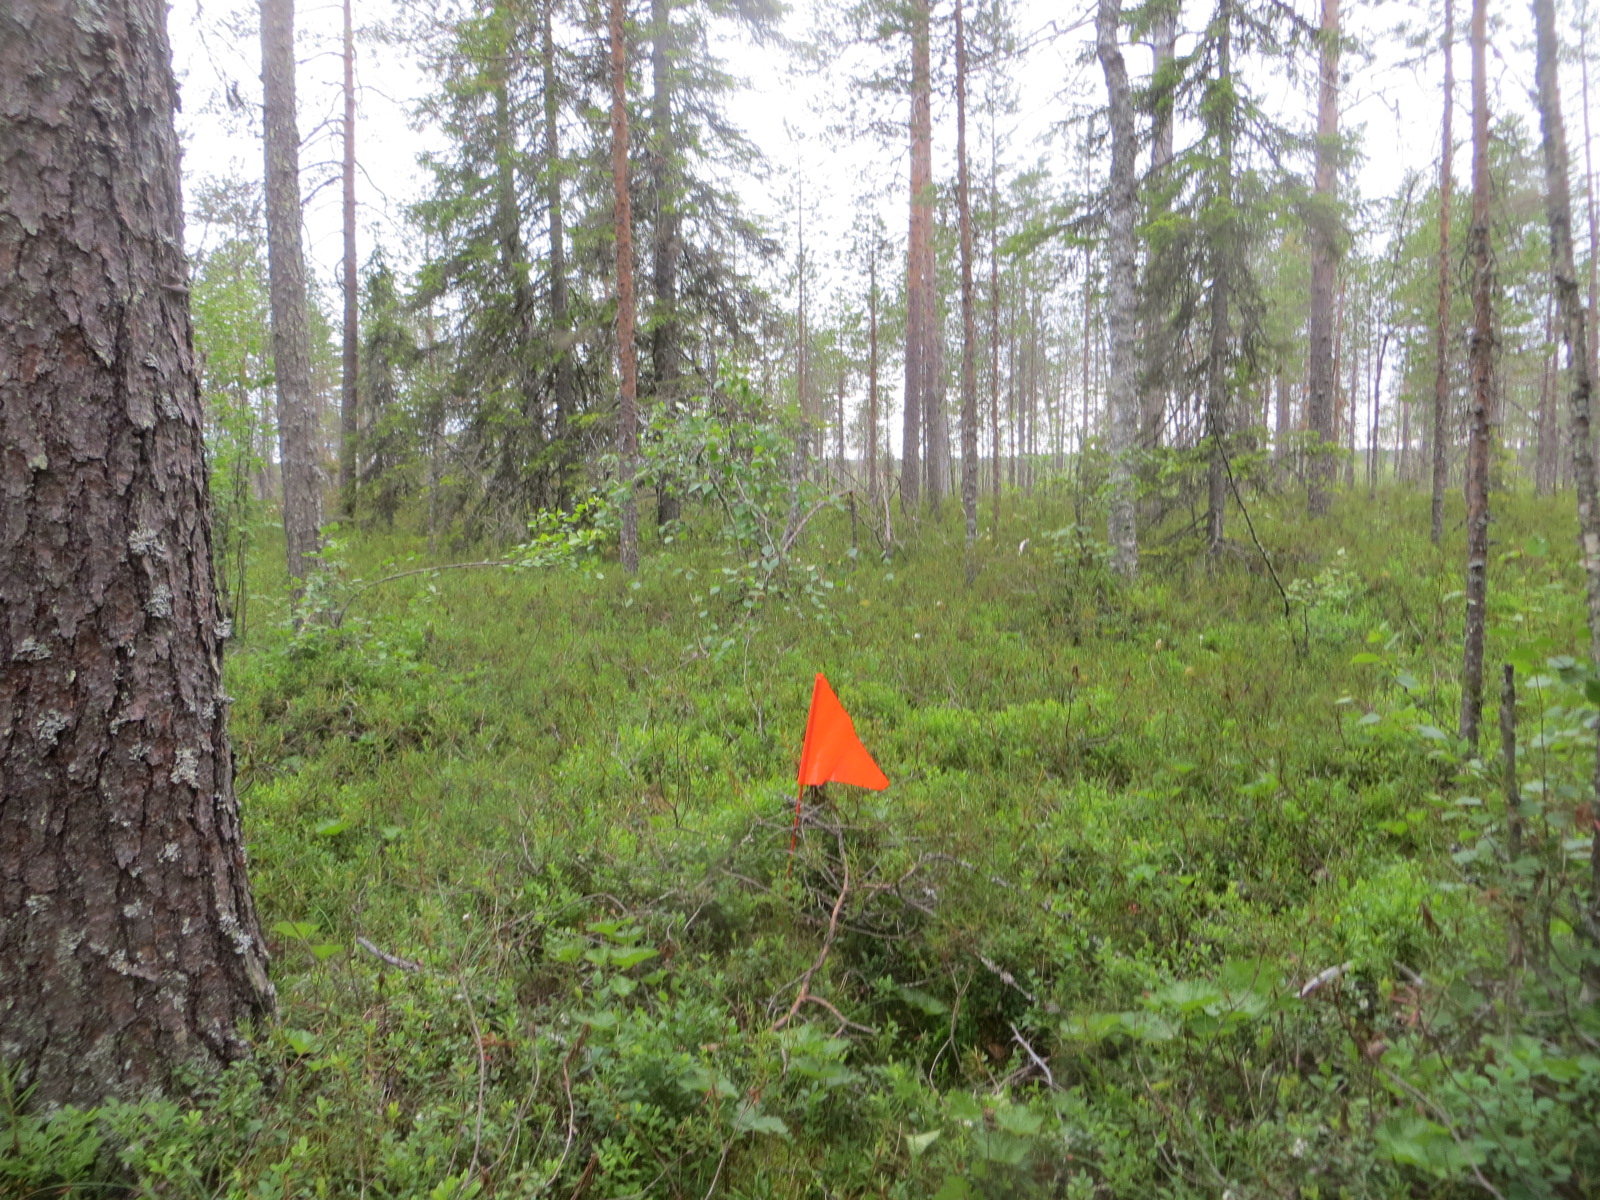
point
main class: Woodland
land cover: Pine dominated coniferous woodland
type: boreal forest
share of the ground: 50 - 75 %
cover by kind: coniferous forest trees 50 %, shrubs 40 %, broadleaved forest trees 10 %
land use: Semi-natural and natural areas not in use
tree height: > 5 m
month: July
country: FI
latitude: 65.8726
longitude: 25.2608
